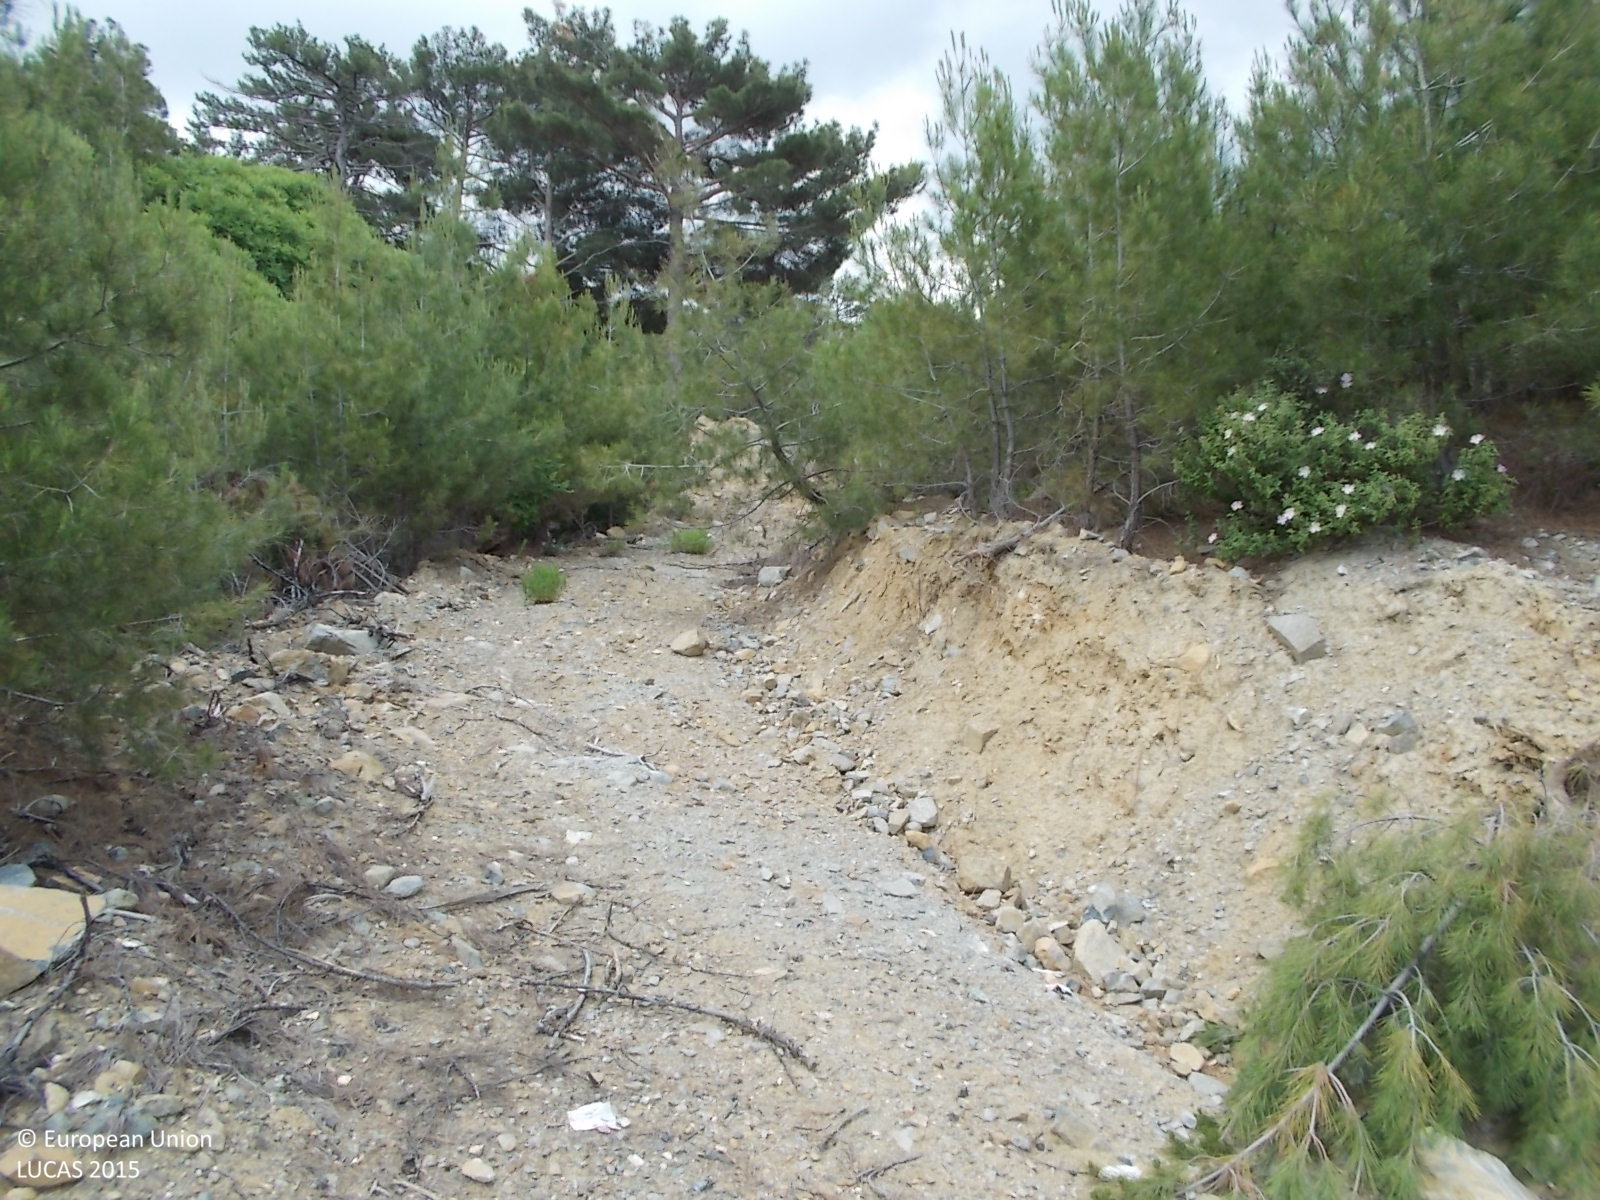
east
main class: Woodland
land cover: Pine dominated coniferous woodland
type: coniferous forest of the mediterranean region
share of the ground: > 75 %
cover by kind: coniferous forest trees 90 %, shrubs 5 %, unconsolidated bare surface 5 %
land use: Forestry
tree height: > 5 m
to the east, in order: Pine dominated coniferous woodland; Paved roads, cycling and walking lanes; Pine dominated coniferous woodland; Pine dominated mixed woodland; Tracks; Pine dominated mixed woodland
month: June
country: CY
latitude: 34.9119
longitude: 32.8316
